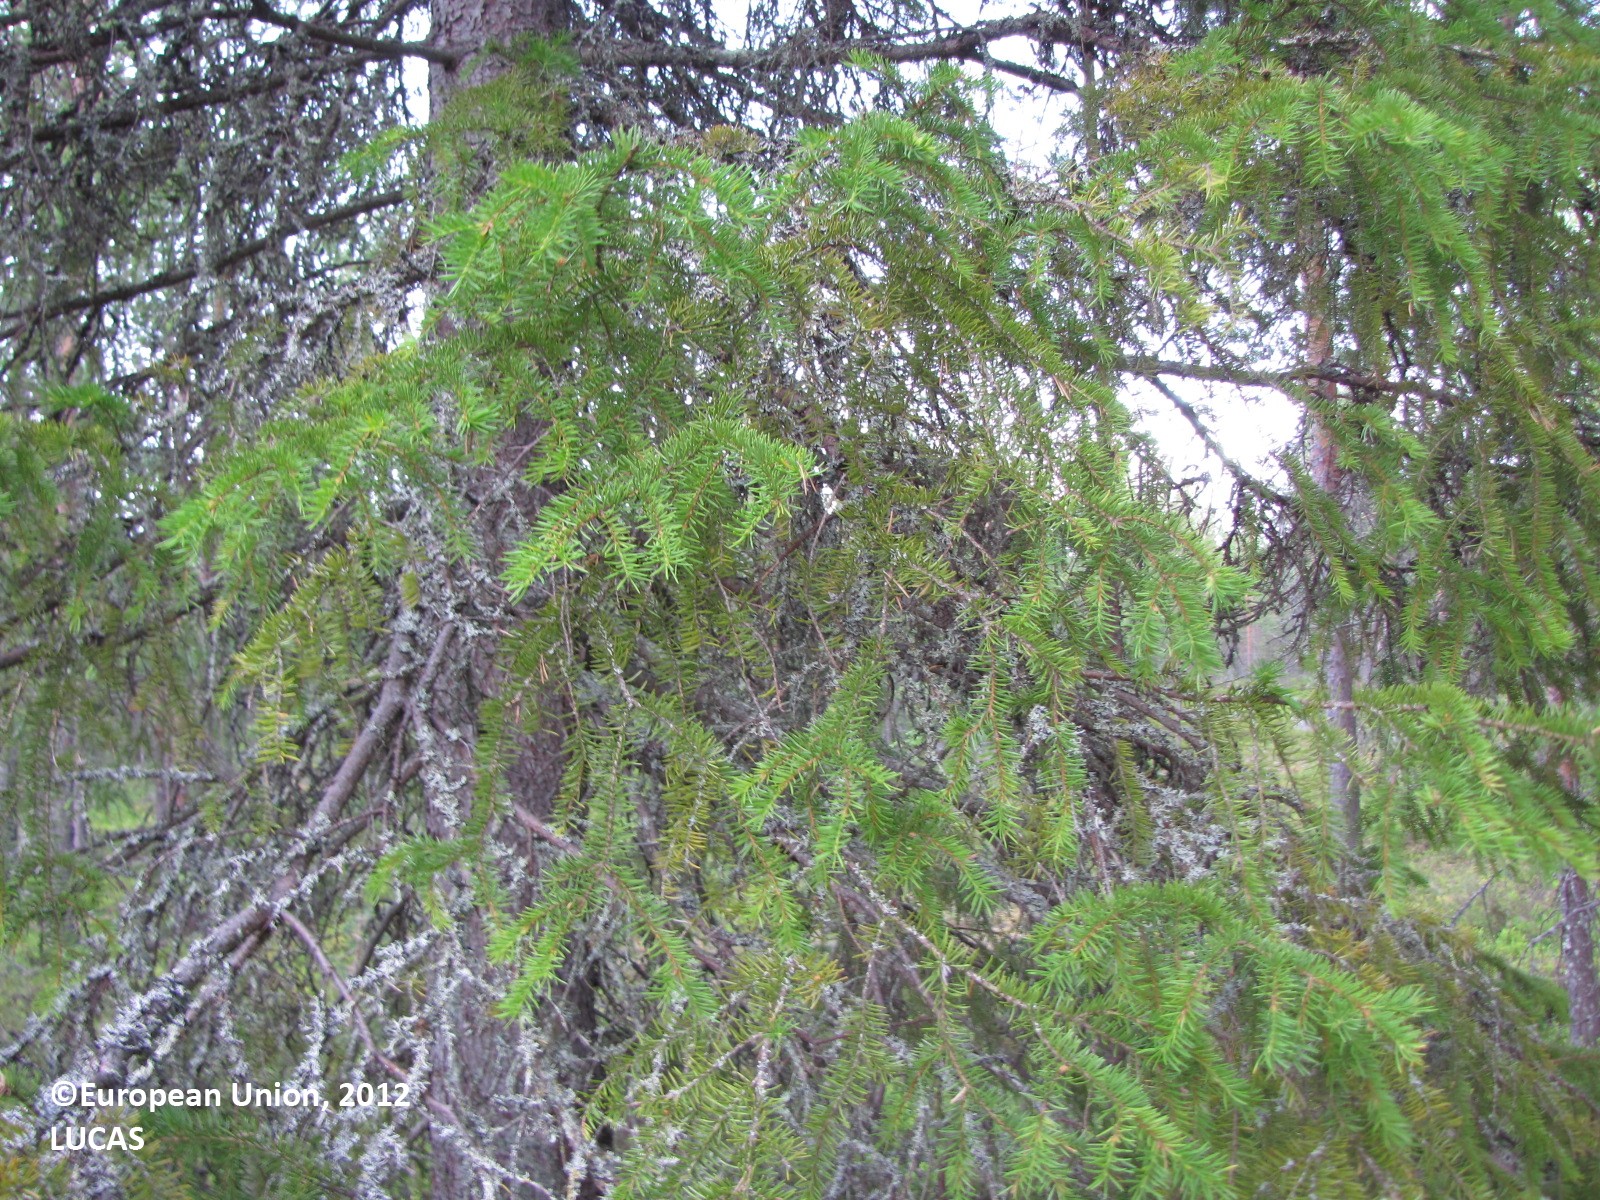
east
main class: Woodland
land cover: Pine dominated coniferous woodland
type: boreal forest
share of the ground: 50 - 75 %
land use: Forestry
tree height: > 5 m
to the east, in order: Pine dominated coniferous woodland
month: July
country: FI
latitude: 66.3958
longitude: 25.2110
